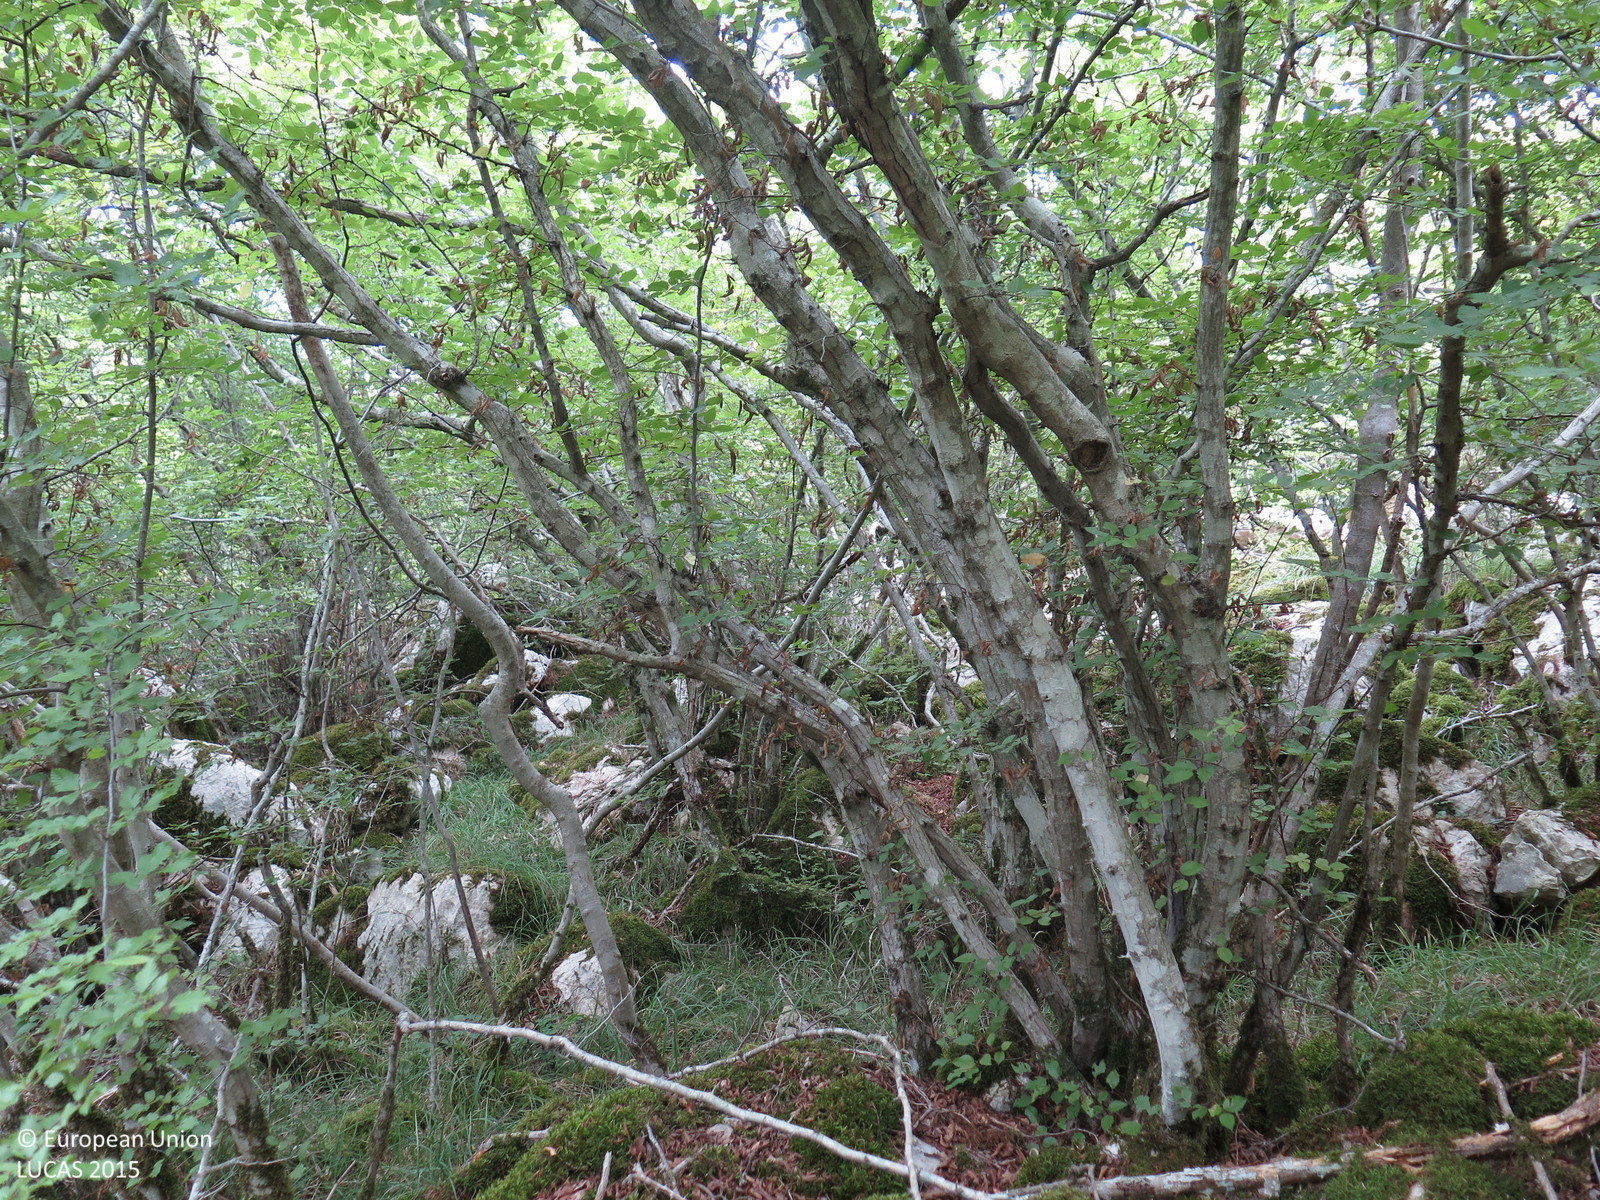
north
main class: Woodland
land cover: Broadleaved woodland
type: thermophilous deciduous forest
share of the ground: > 75 %
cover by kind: broadleaved forest trees 90 %, lichens and mosses 5 %, unconsolidated bare surface 5 %
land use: Semi-natural and natural areas not in use
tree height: < 5 m
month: August
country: HR
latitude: 45.1161
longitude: 14.5834
